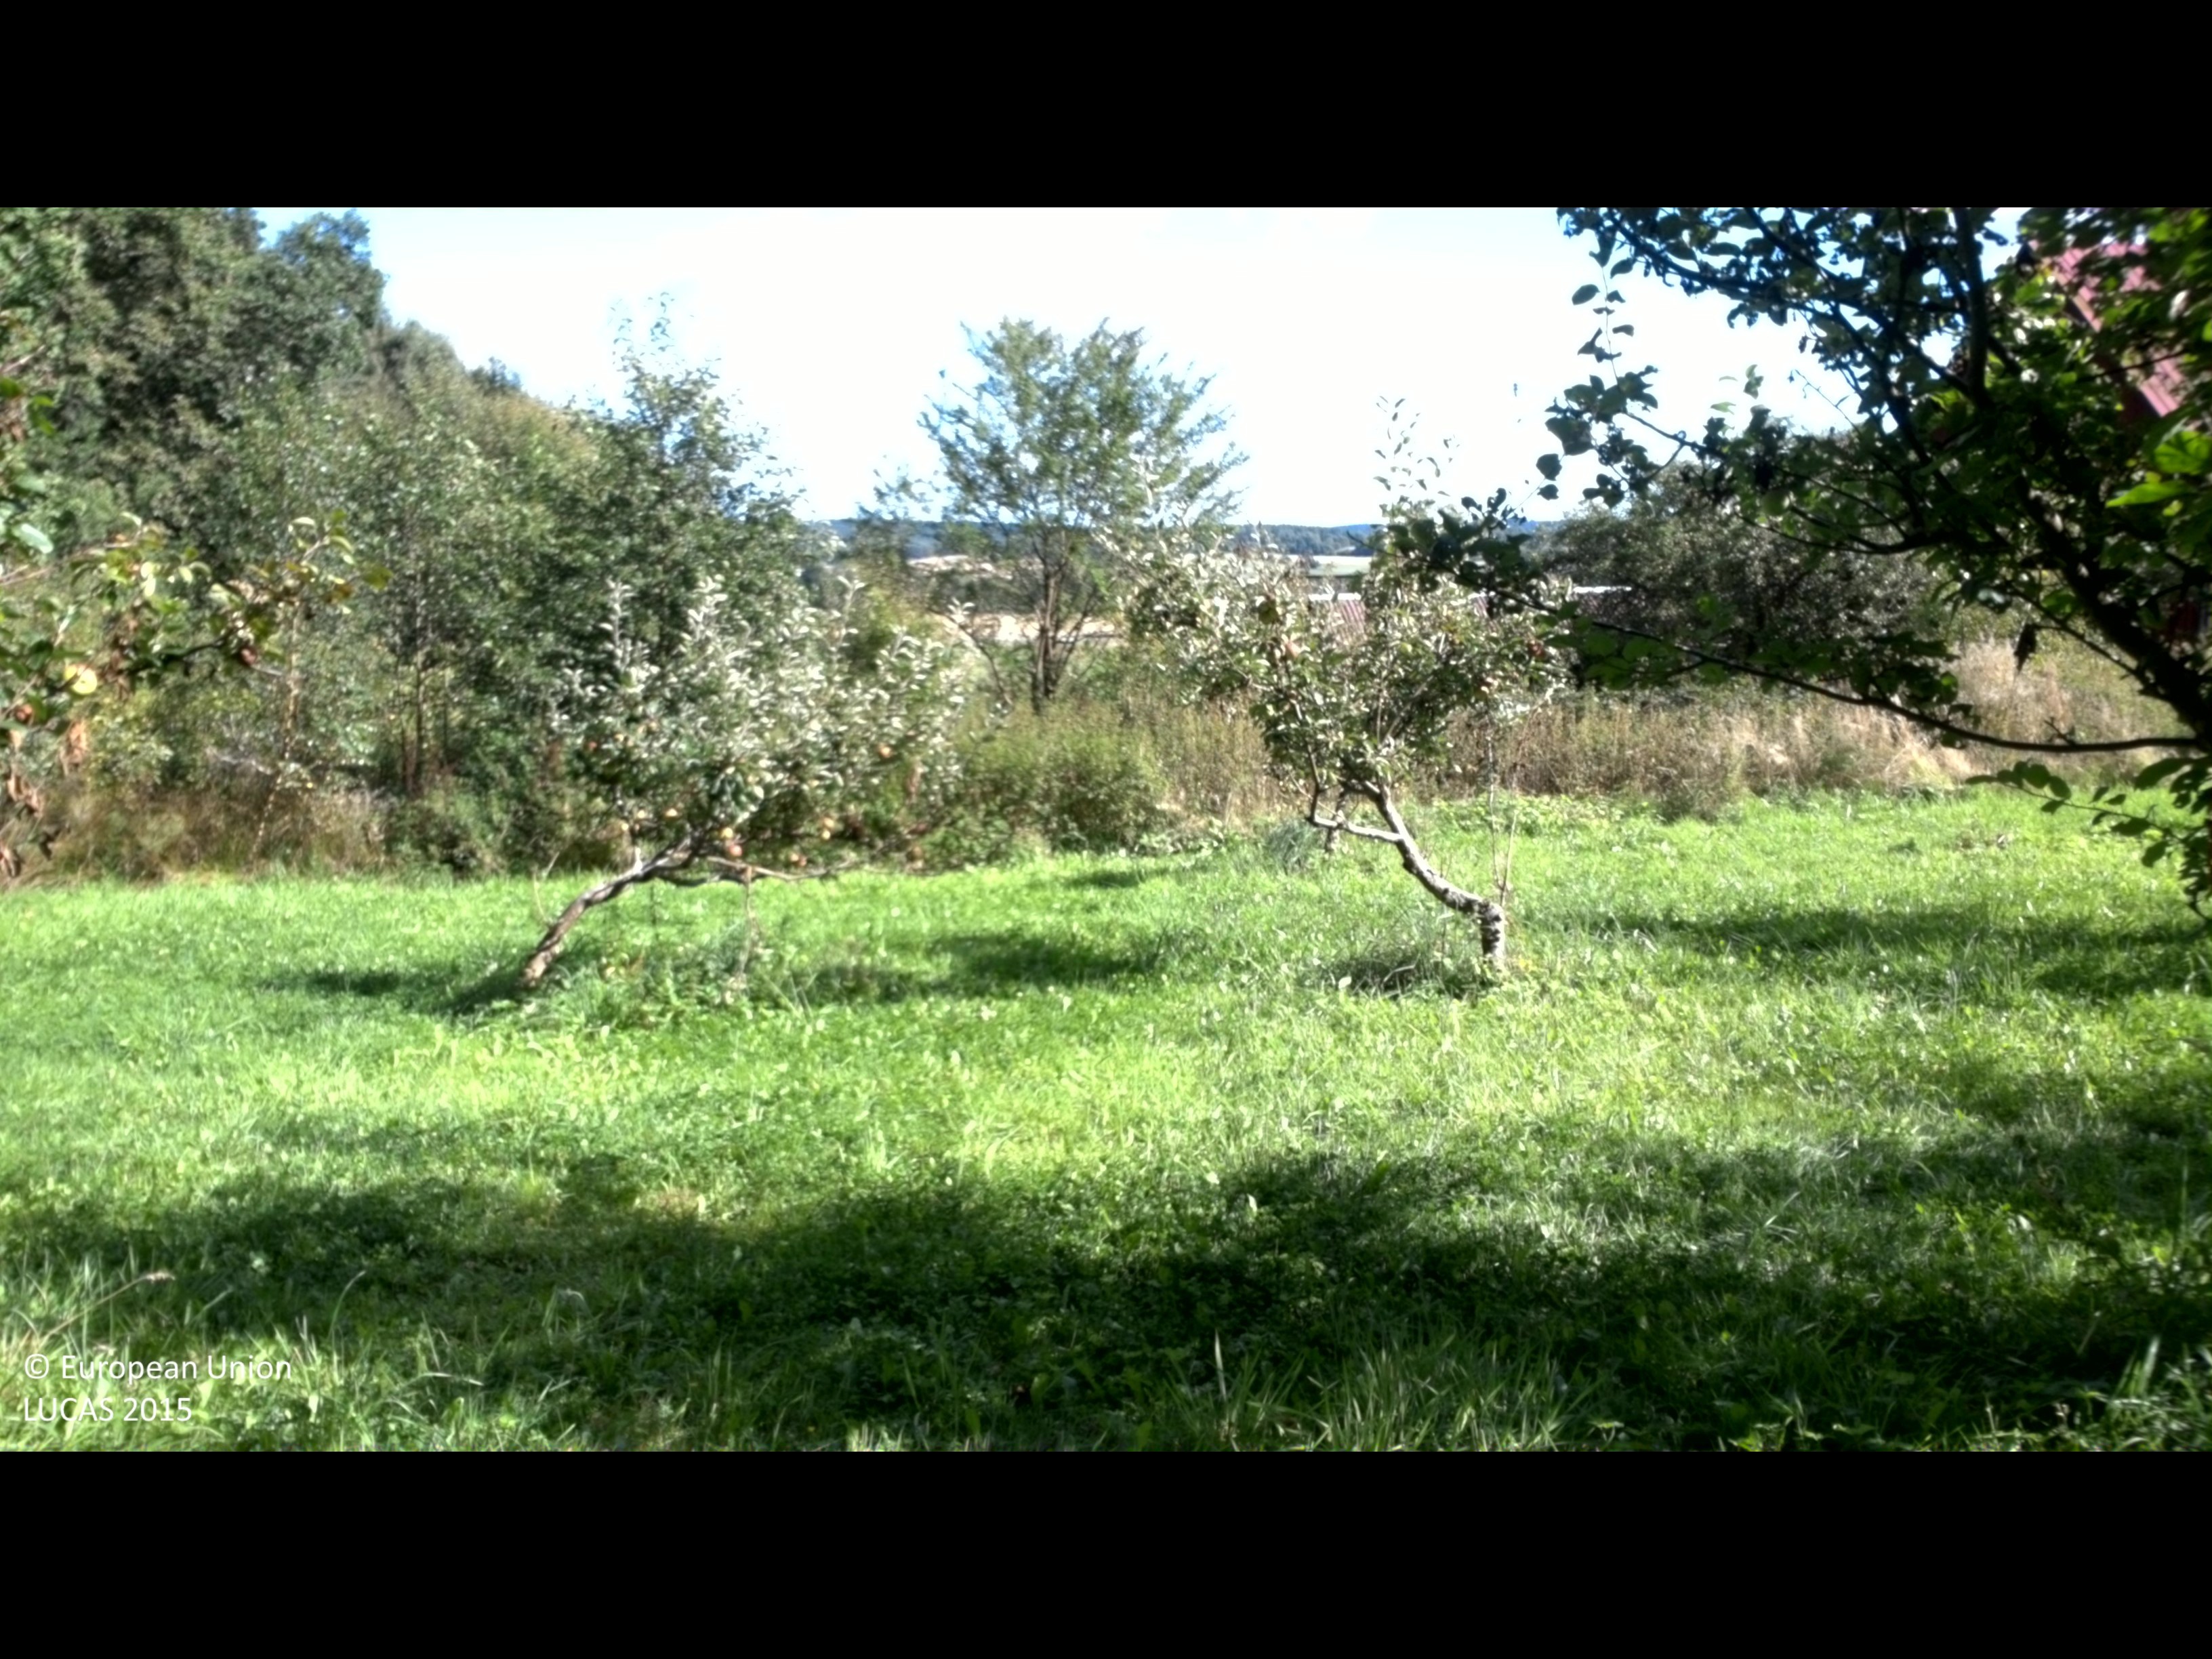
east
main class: Cropland
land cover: Apple fruit
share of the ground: 25 - 50 %
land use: Kitchen garden
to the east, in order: Apple fruit; Broadleaved woodland; Other leguminous and mixtures for fodder
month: September
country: SE
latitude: 56.1644
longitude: 14.4586
